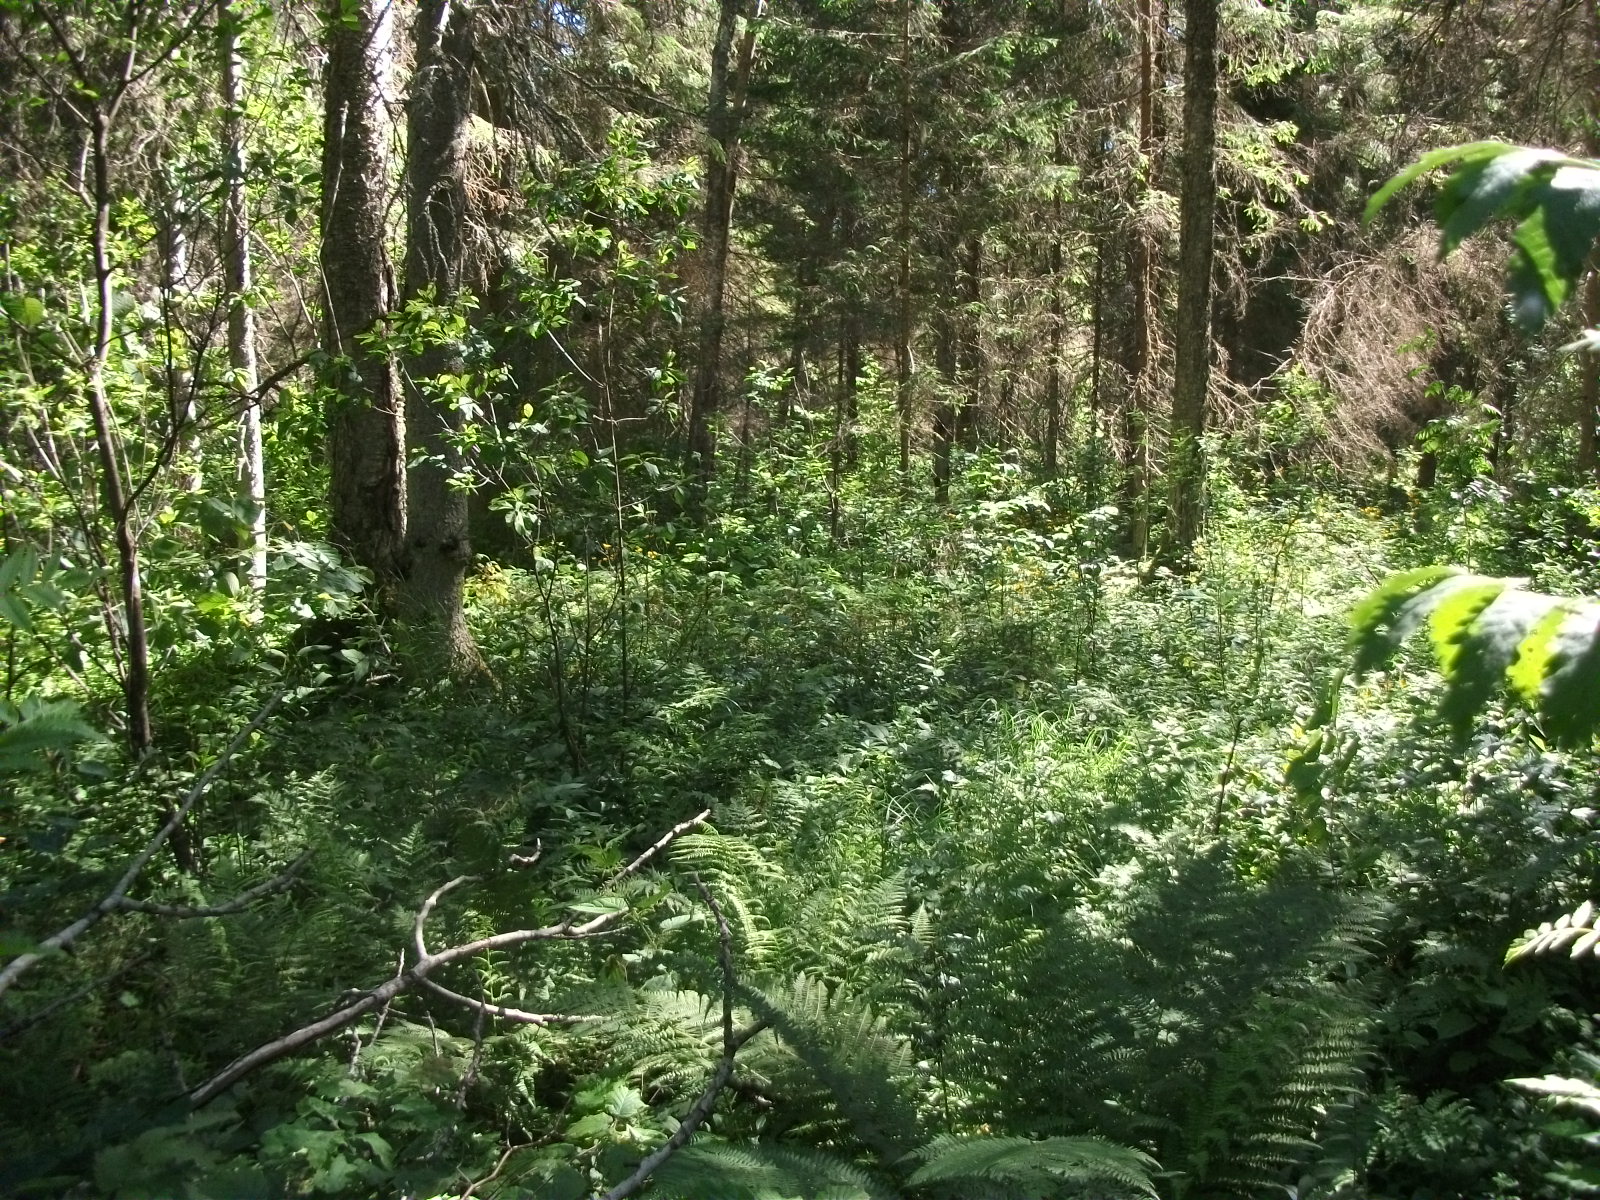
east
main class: Woodland
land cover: Spruce dominated coniferous woodland
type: hemiboreal forest and nemoral coniferous forest and mixed broadleaved-coniferous forest
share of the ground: > 75 %
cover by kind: coniferous forest trees 75 %, broadleaved forest trees 10 %, shrubs 10 %, herbaceous plants 5 %
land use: Forestry
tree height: > 5 m
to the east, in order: Spruce dominated coniferous woodland; Ditches and canals; Spruce dominated coniferous woodland
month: July
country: LV
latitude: 56.7545
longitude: 26.1481
